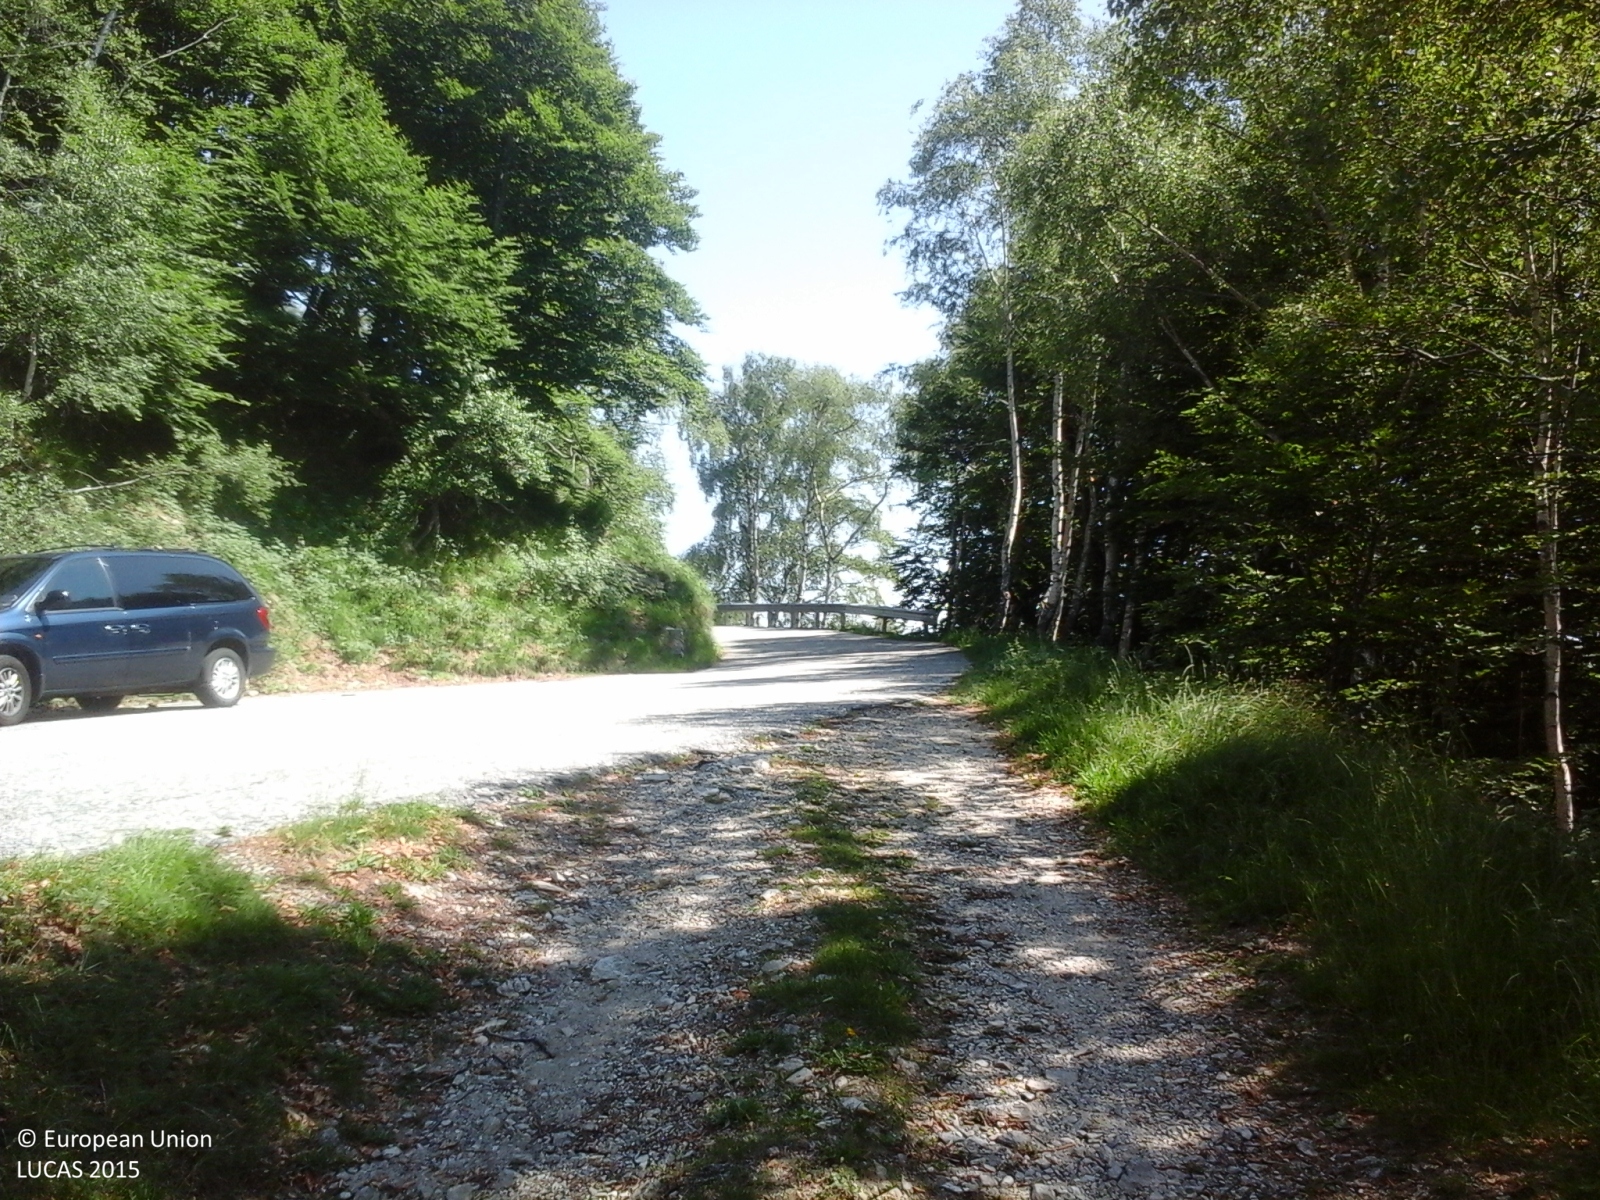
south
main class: Woodland
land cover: Broadleaved woodland
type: thermophilous deciduous forest
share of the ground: > 75 %
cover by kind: broadleaved forest trees 100 %
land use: Forestry
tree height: > 5 m
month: June
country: IT
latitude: 46.0180
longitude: 8.6199
